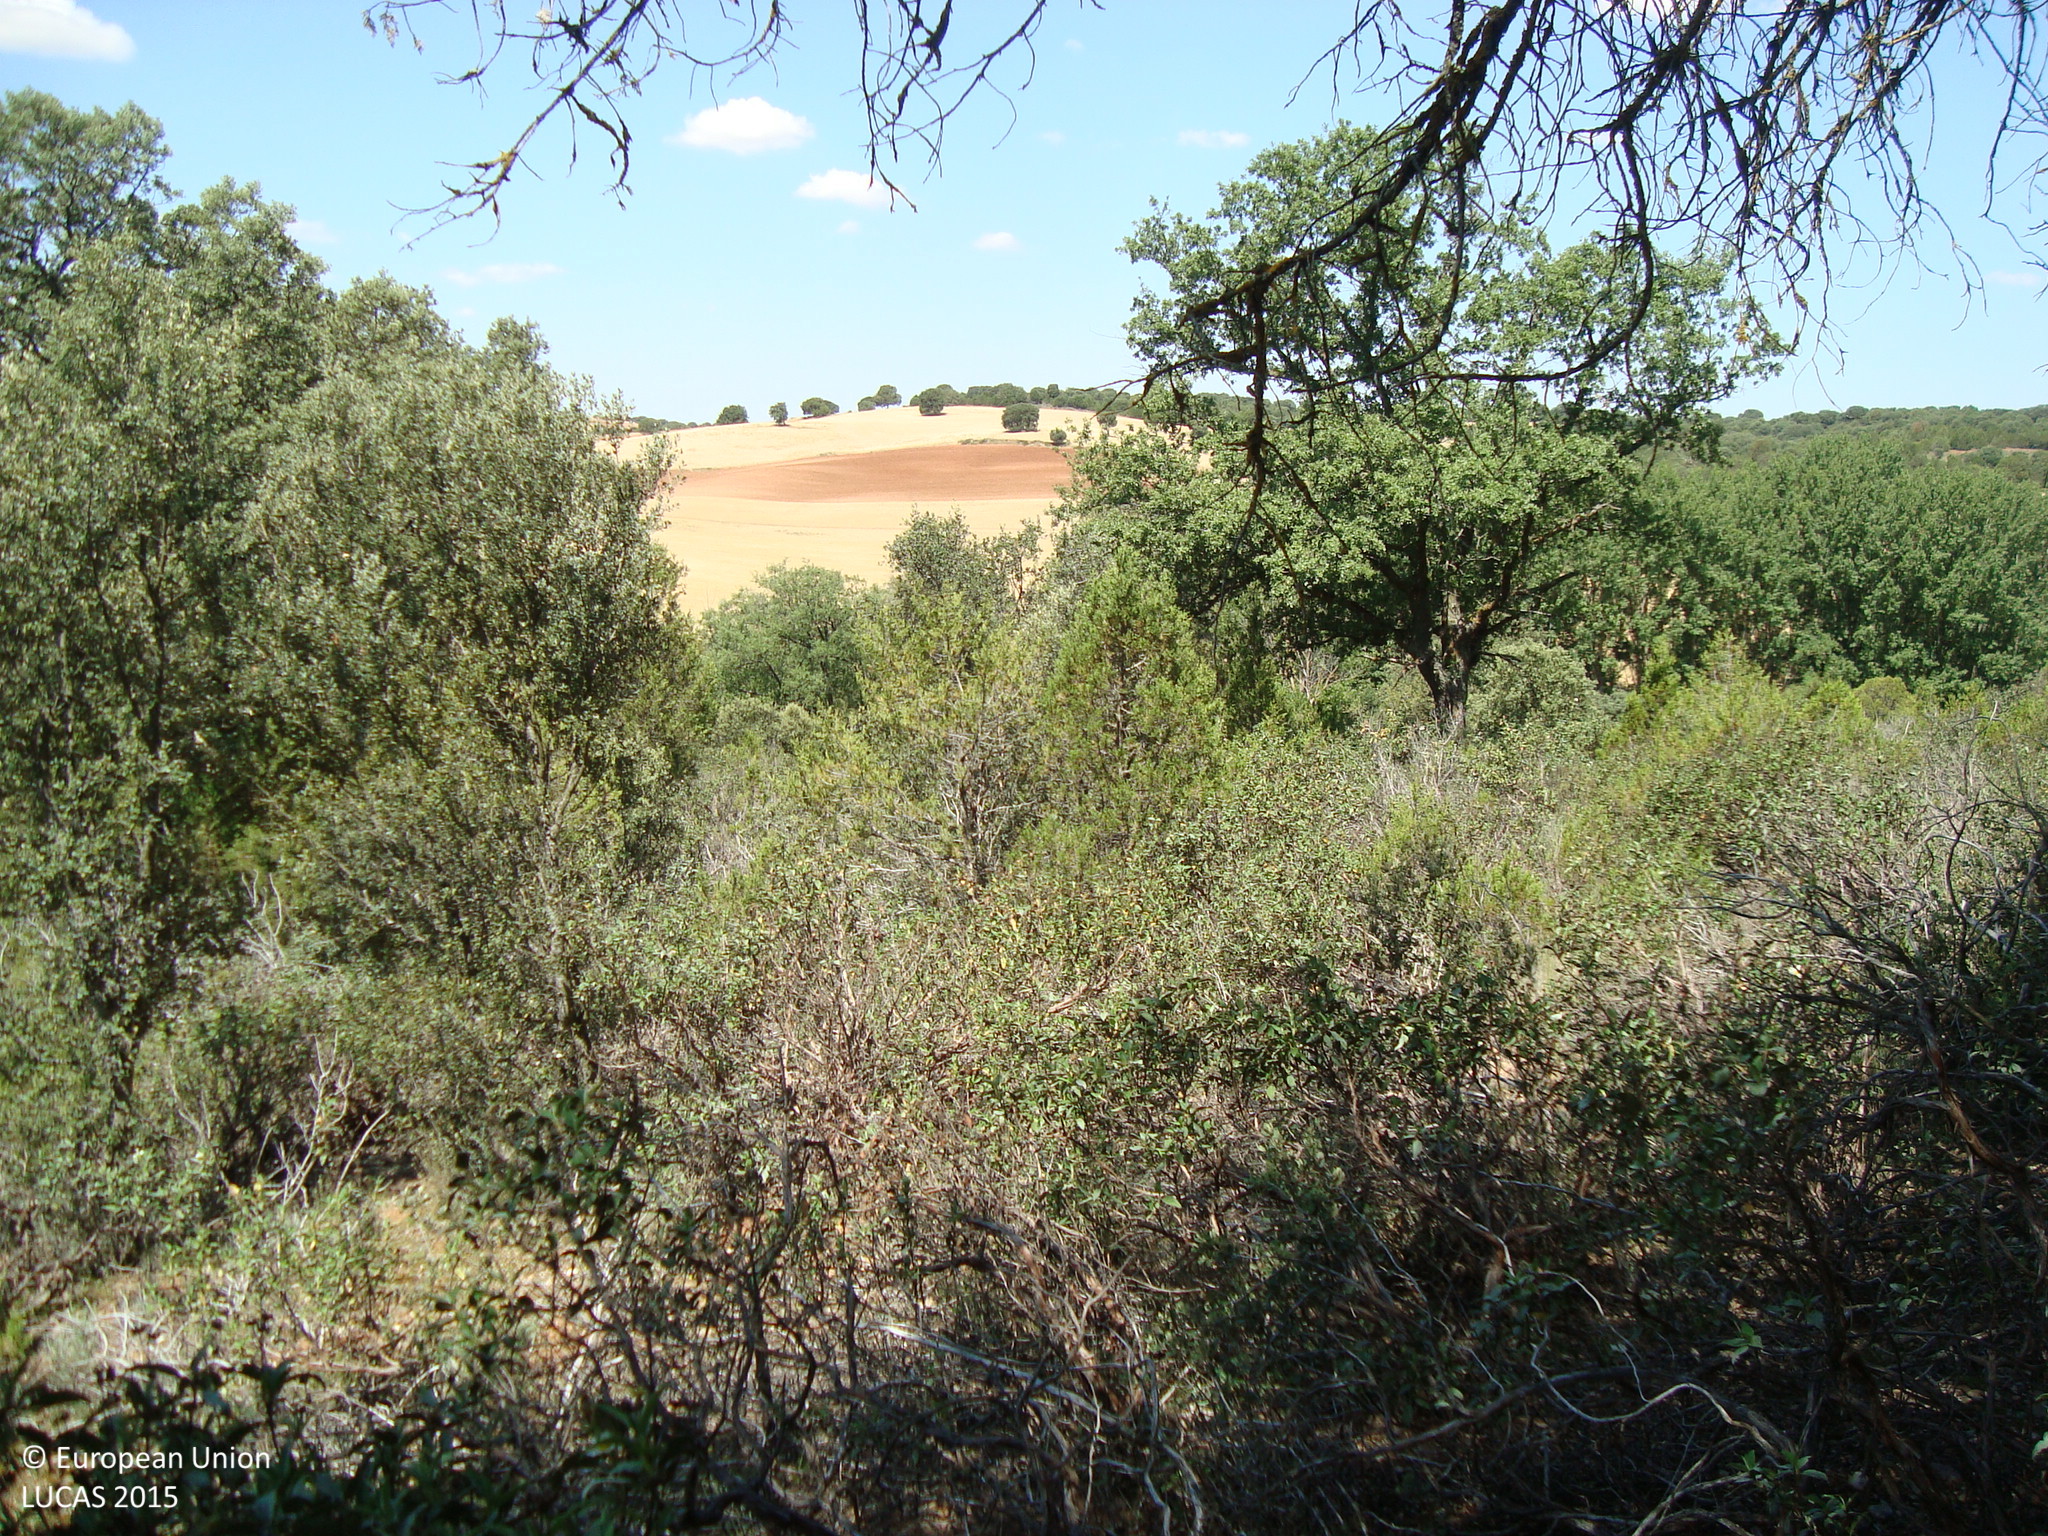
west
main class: Woodland
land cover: Broadleaved woodland
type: broadleaved evergreen forest
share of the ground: 25 - 50 %
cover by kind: broadleaved forest trees 40 %, shrubs 40 %, herbaceous plants 10 %, coniferous forest trees 5 %, unconsolidated bare surface 5 %
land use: Forestry
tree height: > 5 m
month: June
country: ES
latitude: 42.0655
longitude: -3.7017
